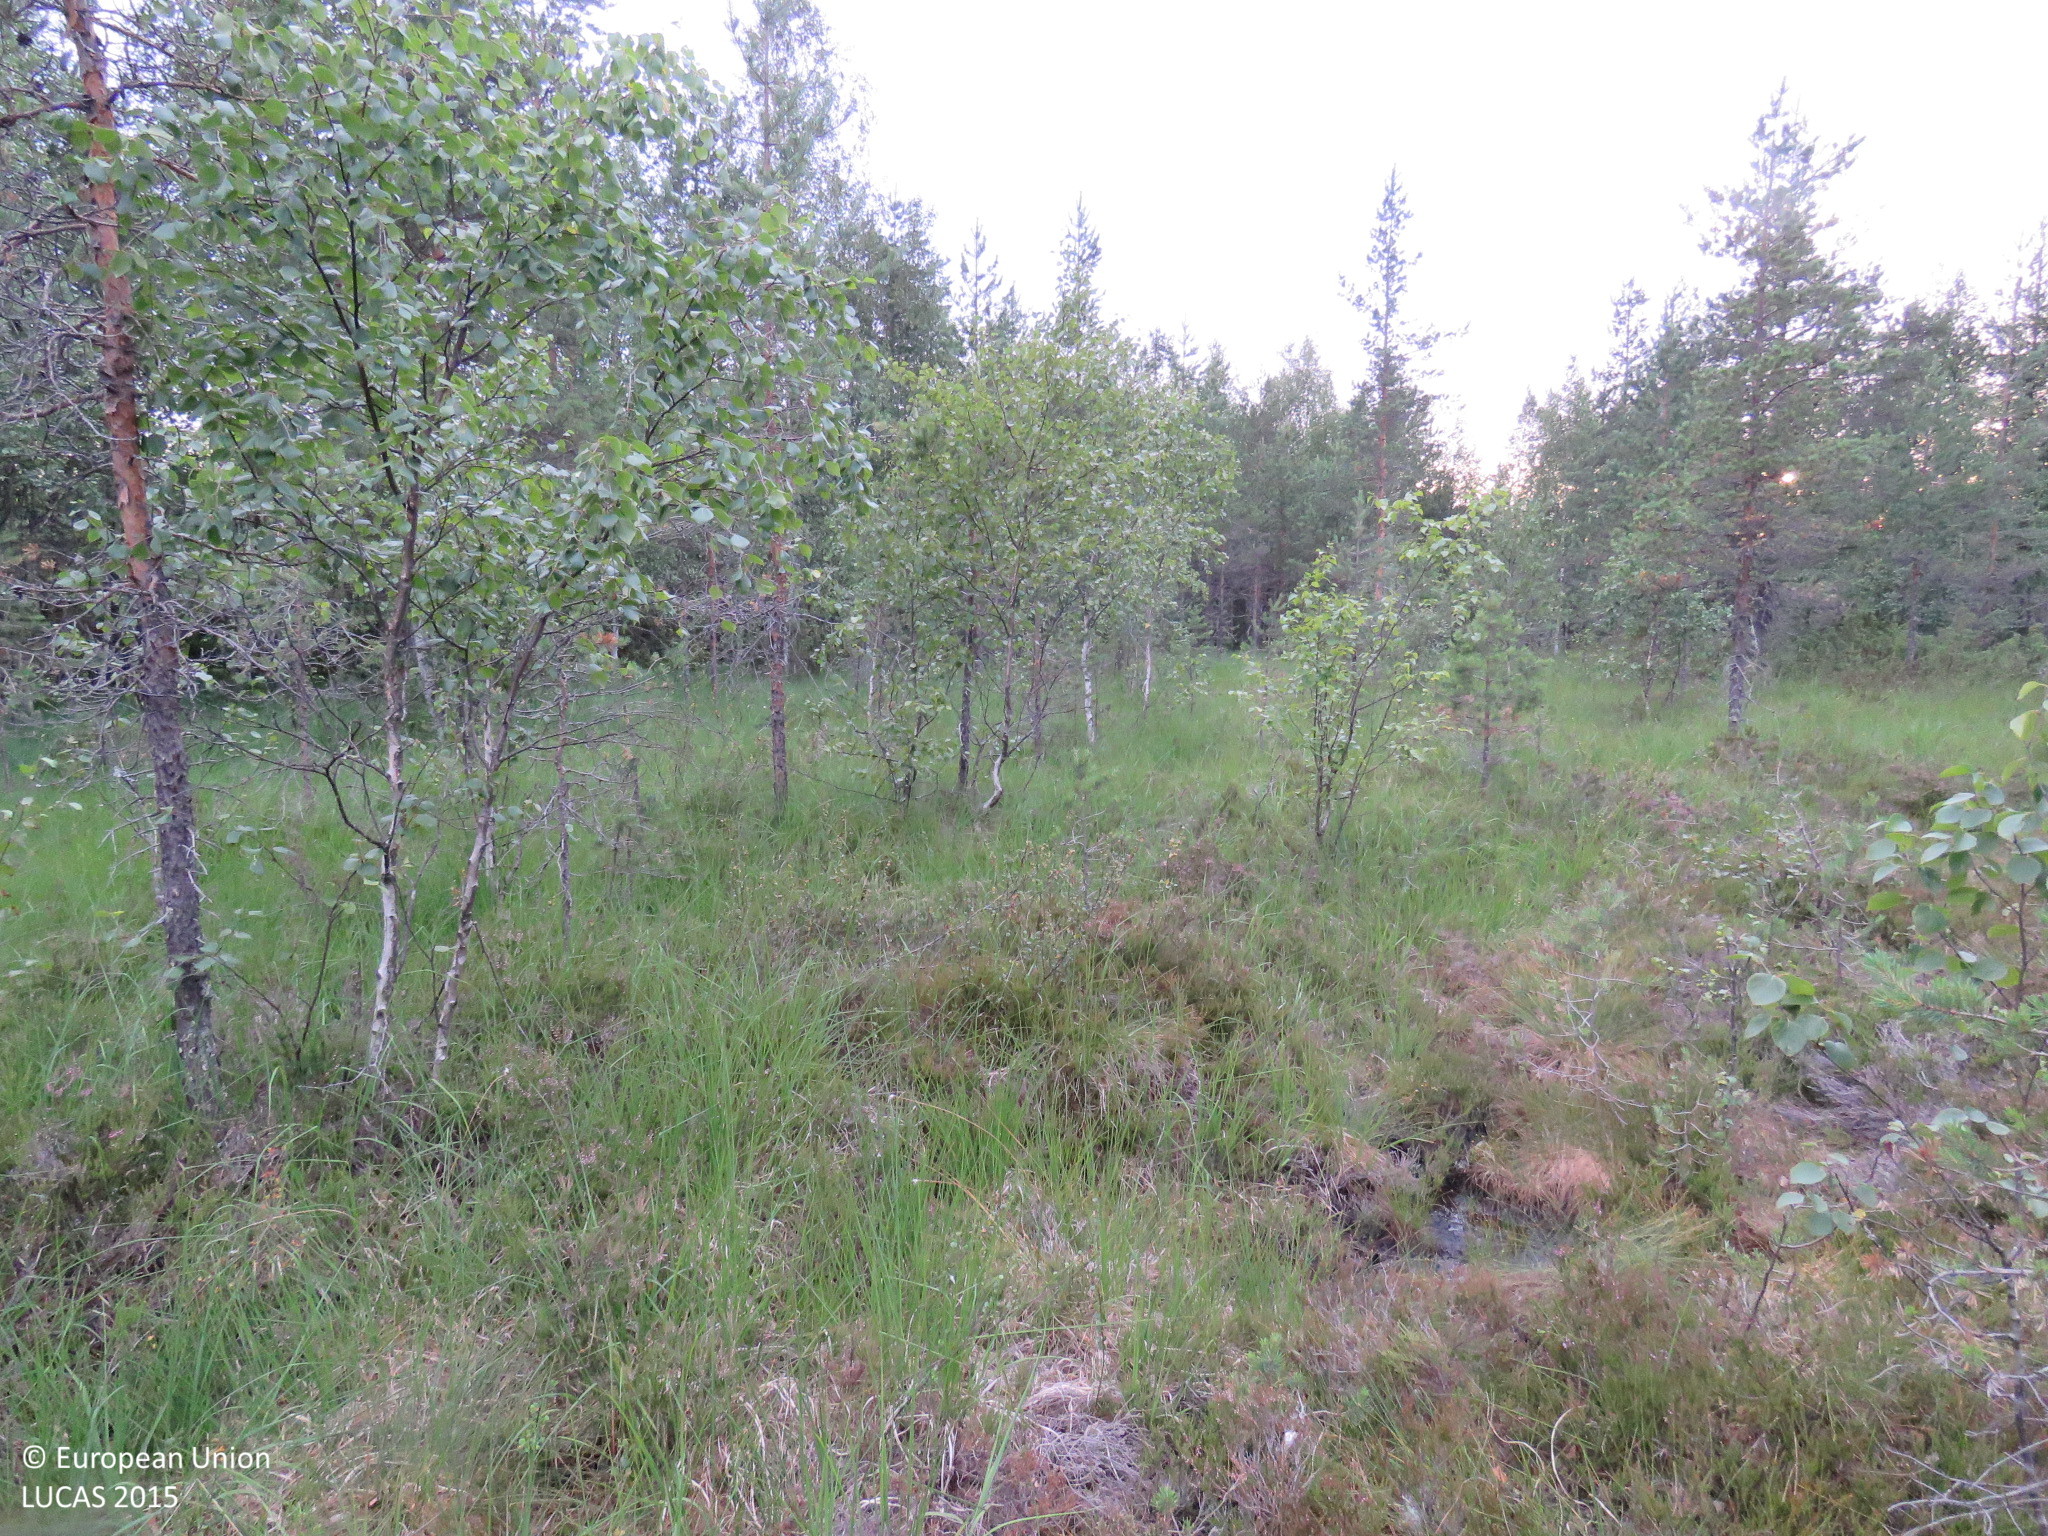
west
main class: Woodland
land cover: Pine dominated mixed woodland
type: mire and swamp forests
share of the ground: > 75 %
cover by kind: broadleaved forest trees 45 %, coniferous forest trees 30 %, shrubs 15 %, herbaceous plants 10 %
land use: Forestry
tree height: > 5 m
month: July
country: FI
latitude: 64.6914
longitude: 26.8734
